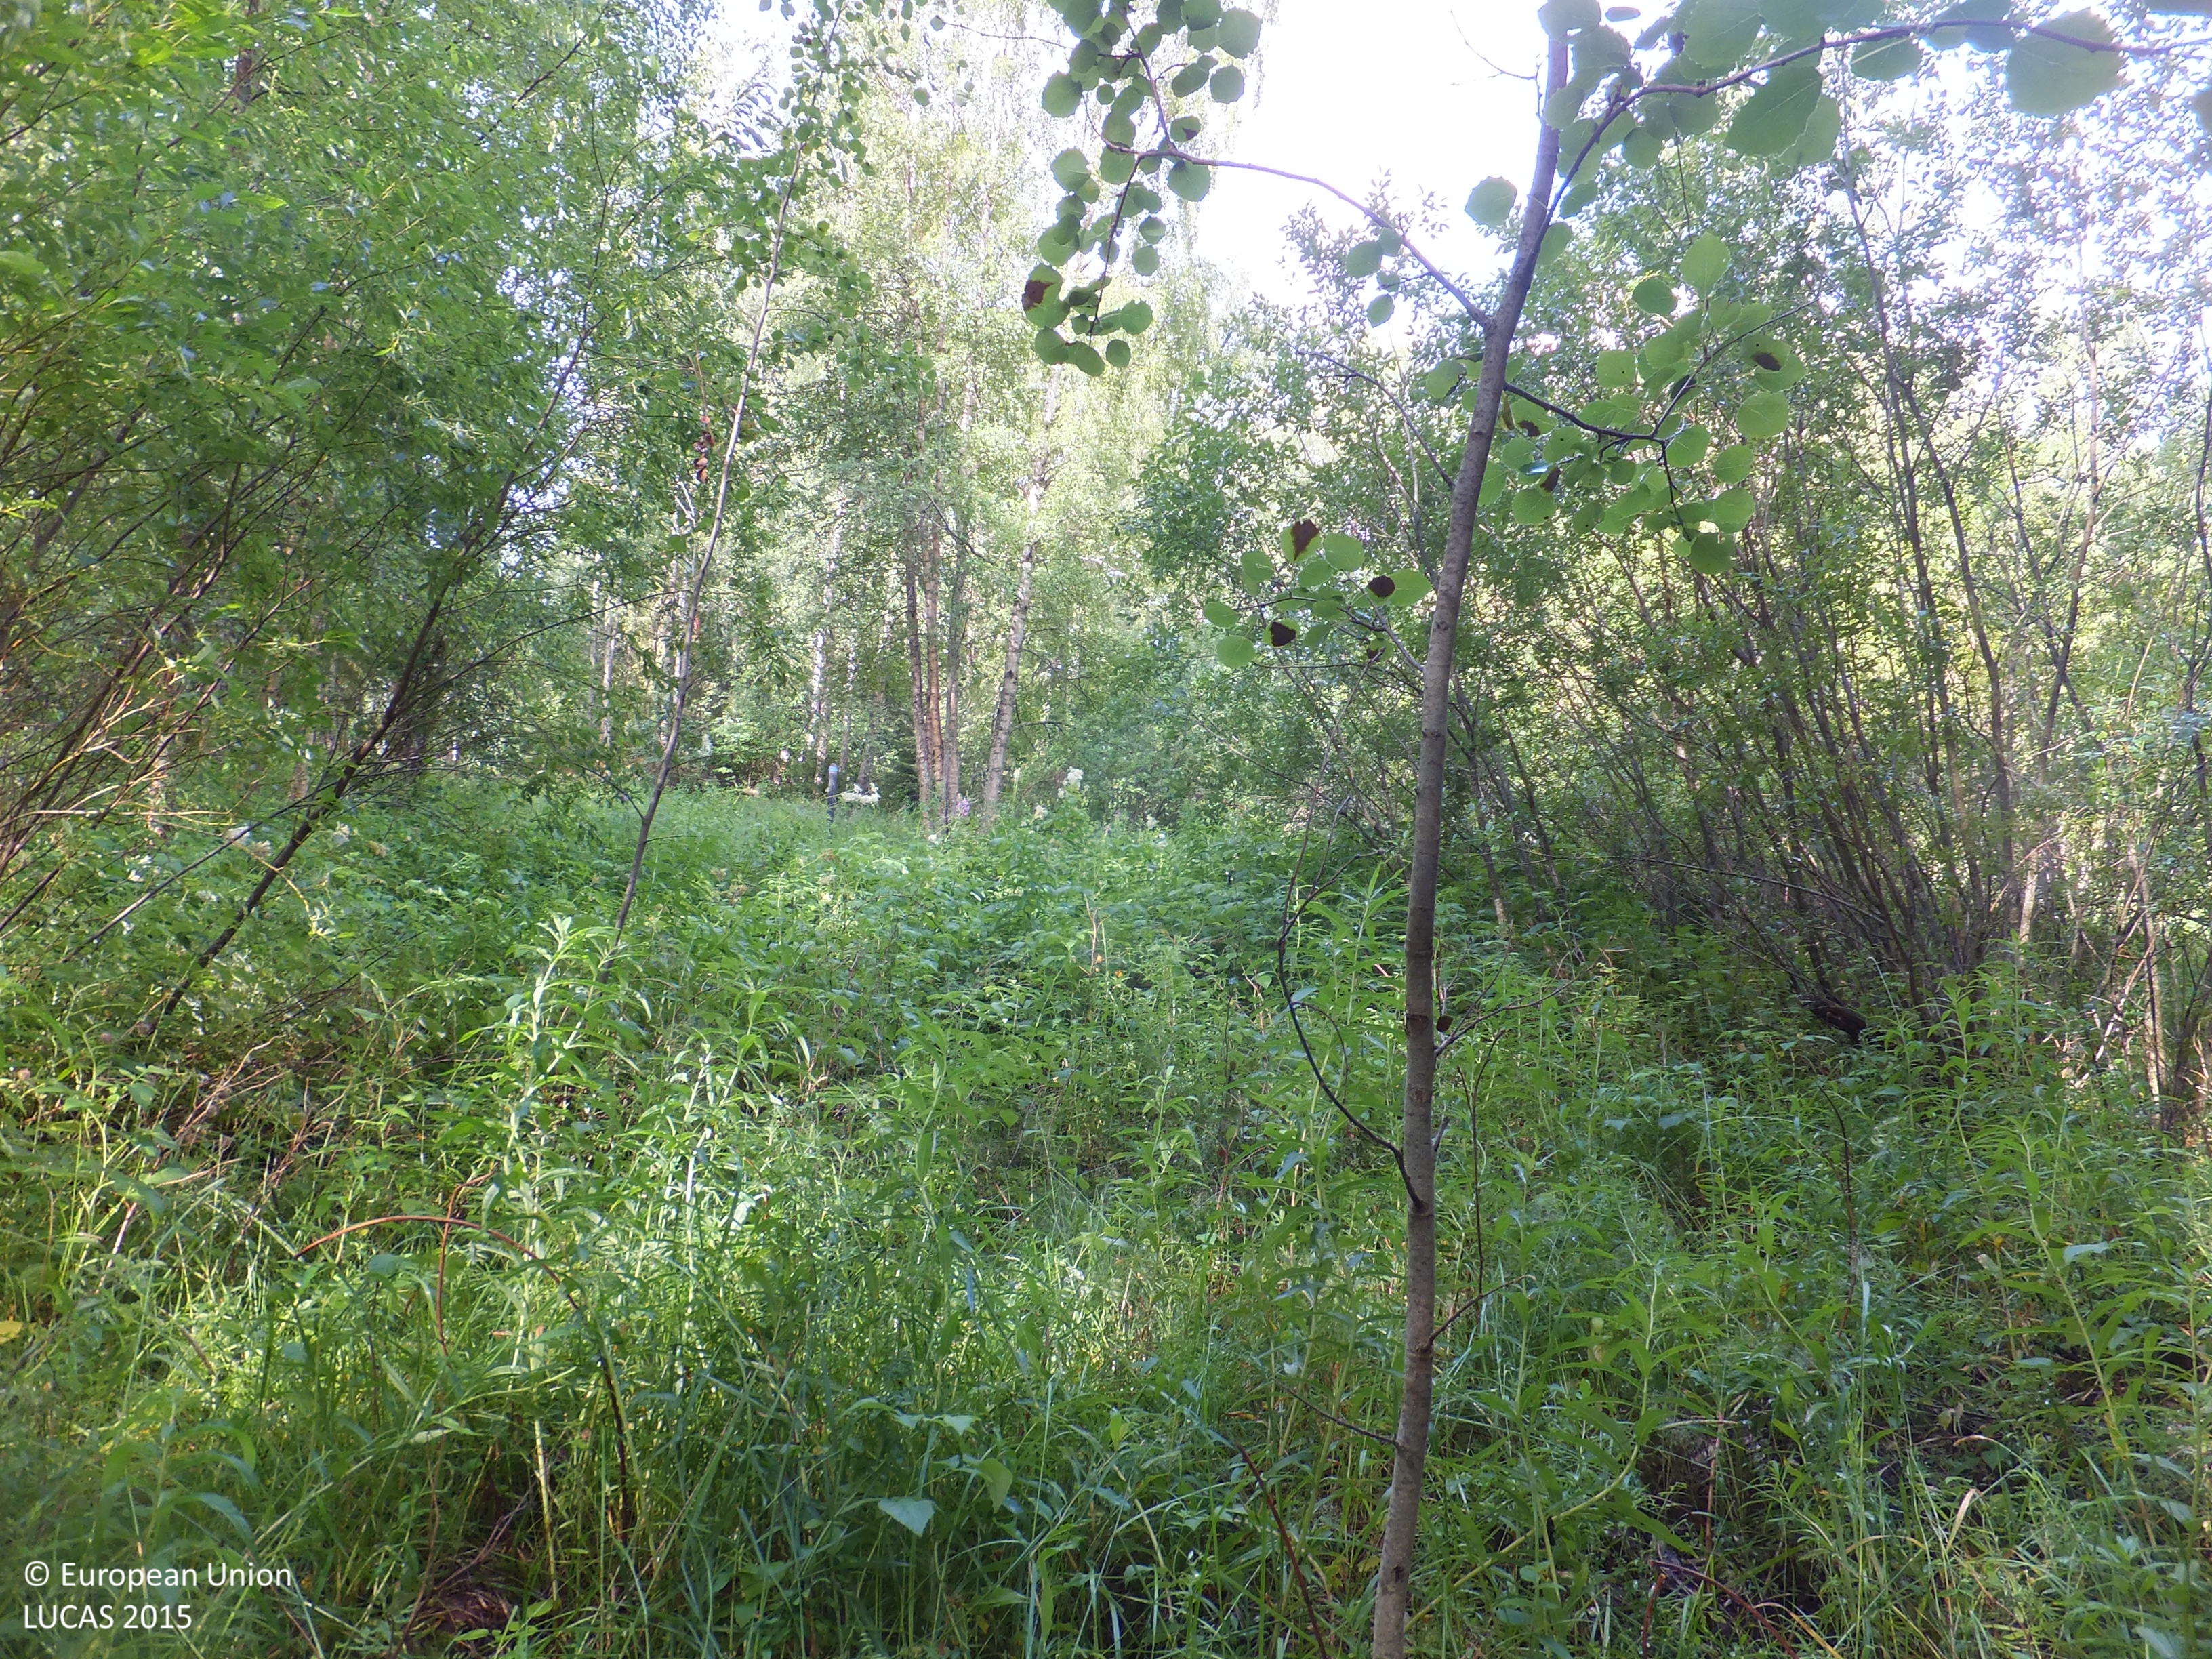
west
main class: Woodland
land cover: Spruce dominated mixed woodland
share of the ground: 50 - 75 %
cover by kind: herbaceous plants 40 %, broadleaved forest trees 30 %, coniferous forest trees 20 %, shrubs 10 %
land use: Semi-natural and natural areas not in use
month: July
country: FI
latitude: 63.1919
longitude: 21.9879
